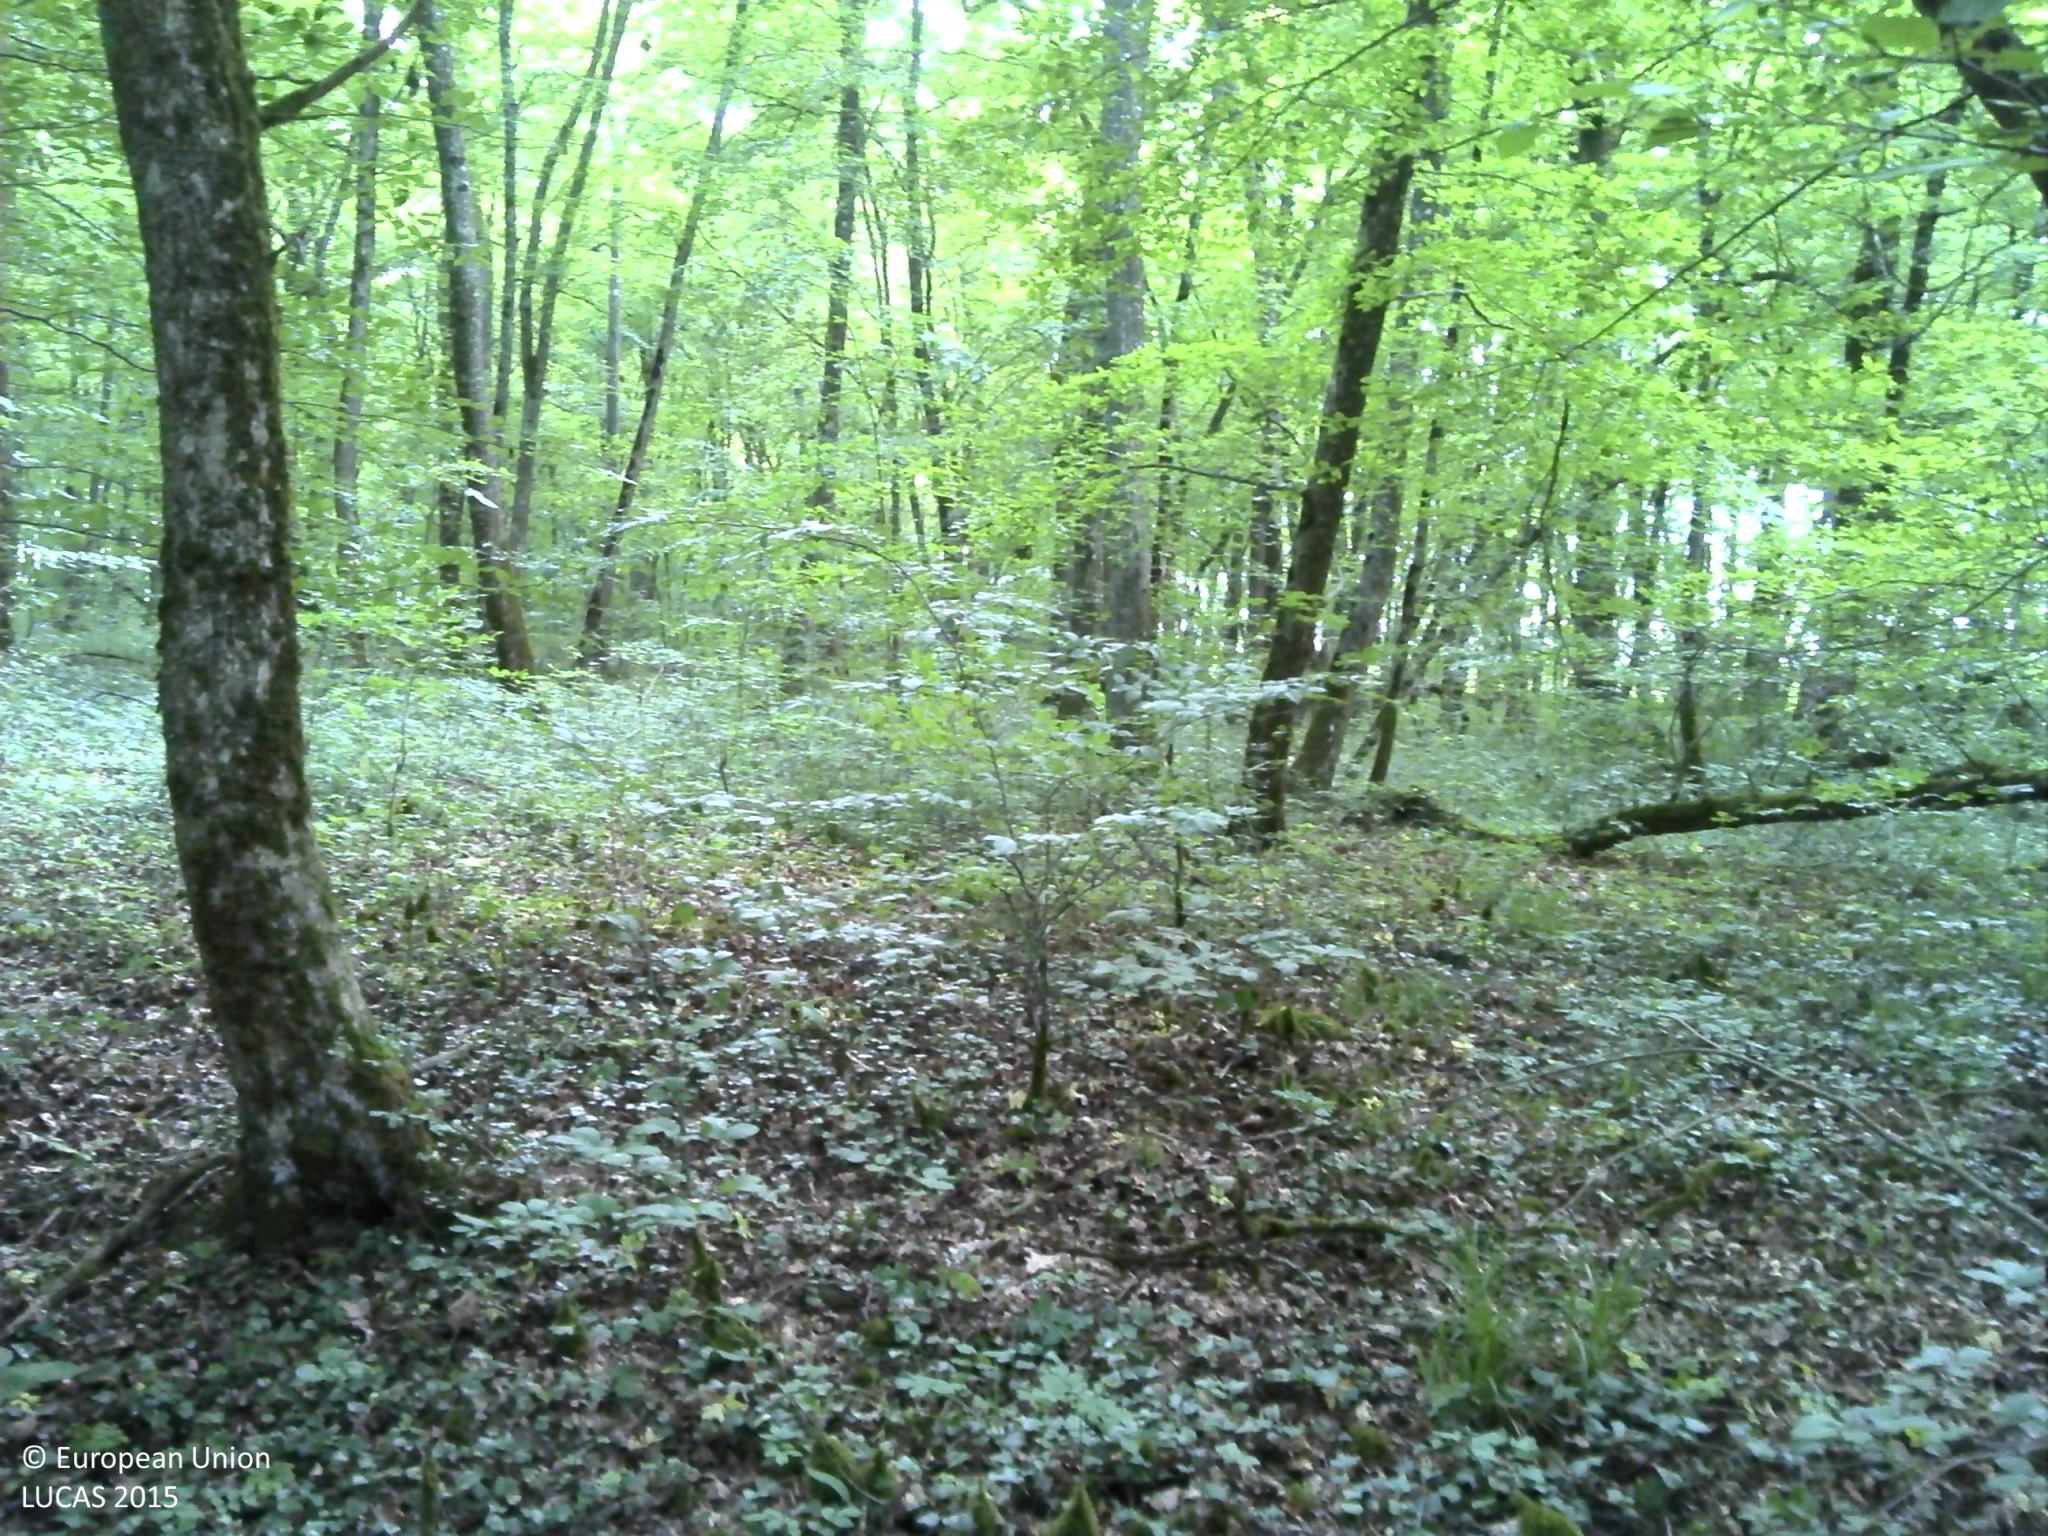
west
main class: Woodland
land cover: Broadleaved woodland
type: beech forest
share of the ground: > 75 %
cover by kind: broadleaved forest trees 90 %, herbaceous plants 10 %
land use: Forestry
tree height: > 5 m
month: June
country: FR
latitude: 48.7363
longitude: 6.8324
